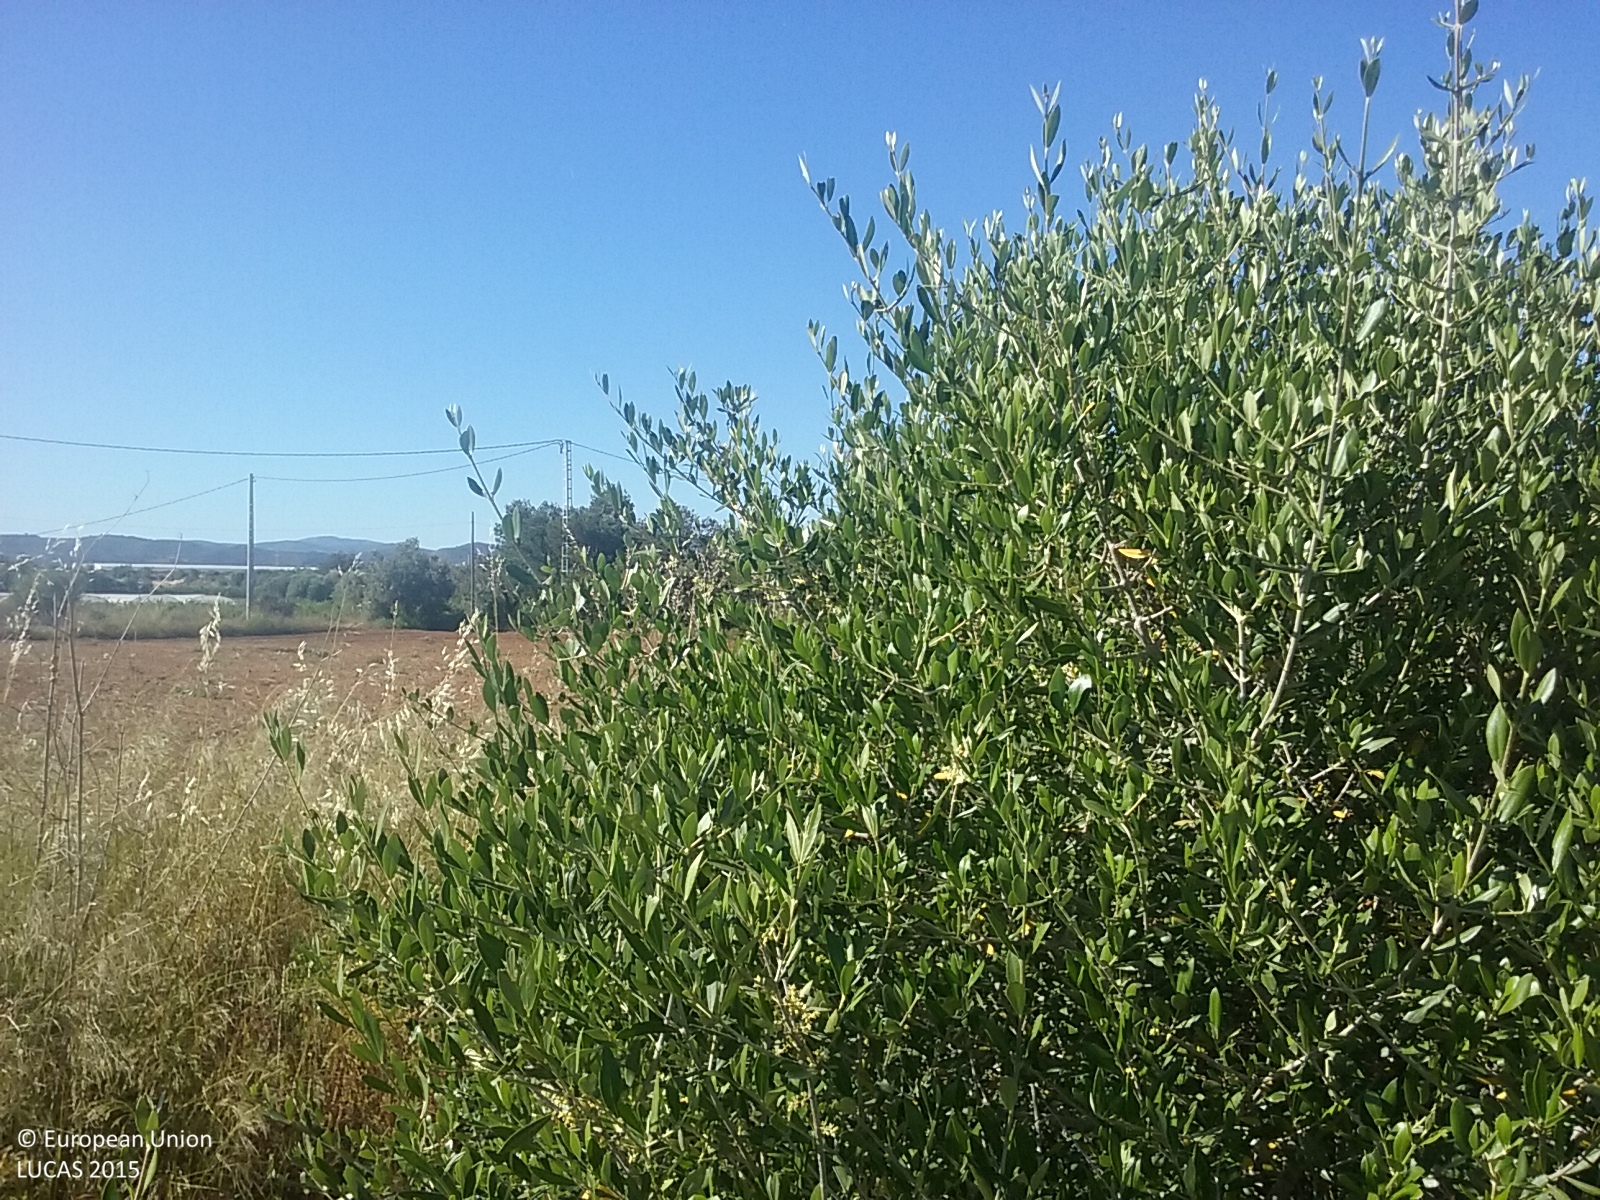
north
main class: Cropland
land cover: Olive groves
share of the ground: 50 - 75 %
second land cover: Grassland without tree/shrub cover
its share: 50 - 75 %
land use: Abandoned areas
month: May
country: ES
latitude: 40.2183
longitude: 0.2567
